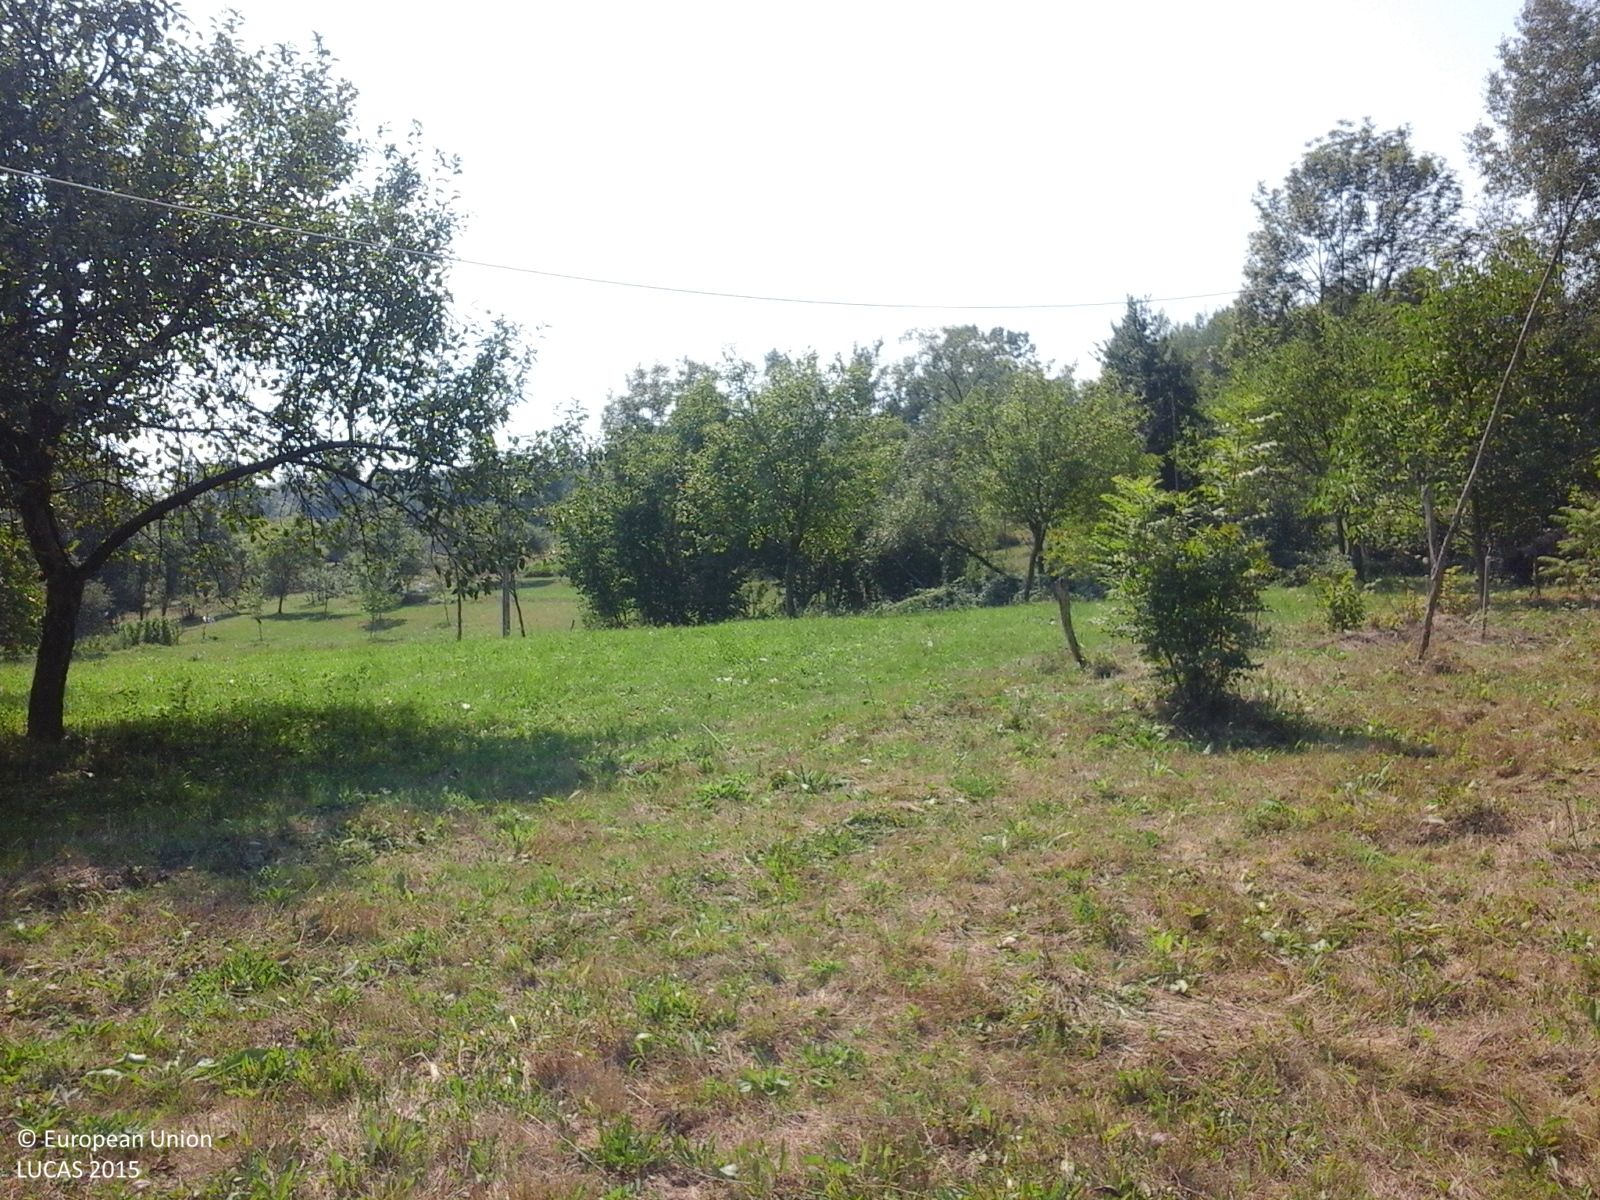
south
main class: Grassland
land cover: Grassland without tree/shrub cover
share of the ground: > 75 %
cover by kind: herbaceous plants 100 %
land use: Agriculture (excluding fallow land and kitchen gardens)
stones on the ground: < 10 %
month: August
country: RO
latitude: 46.3420
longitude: 22.5107
